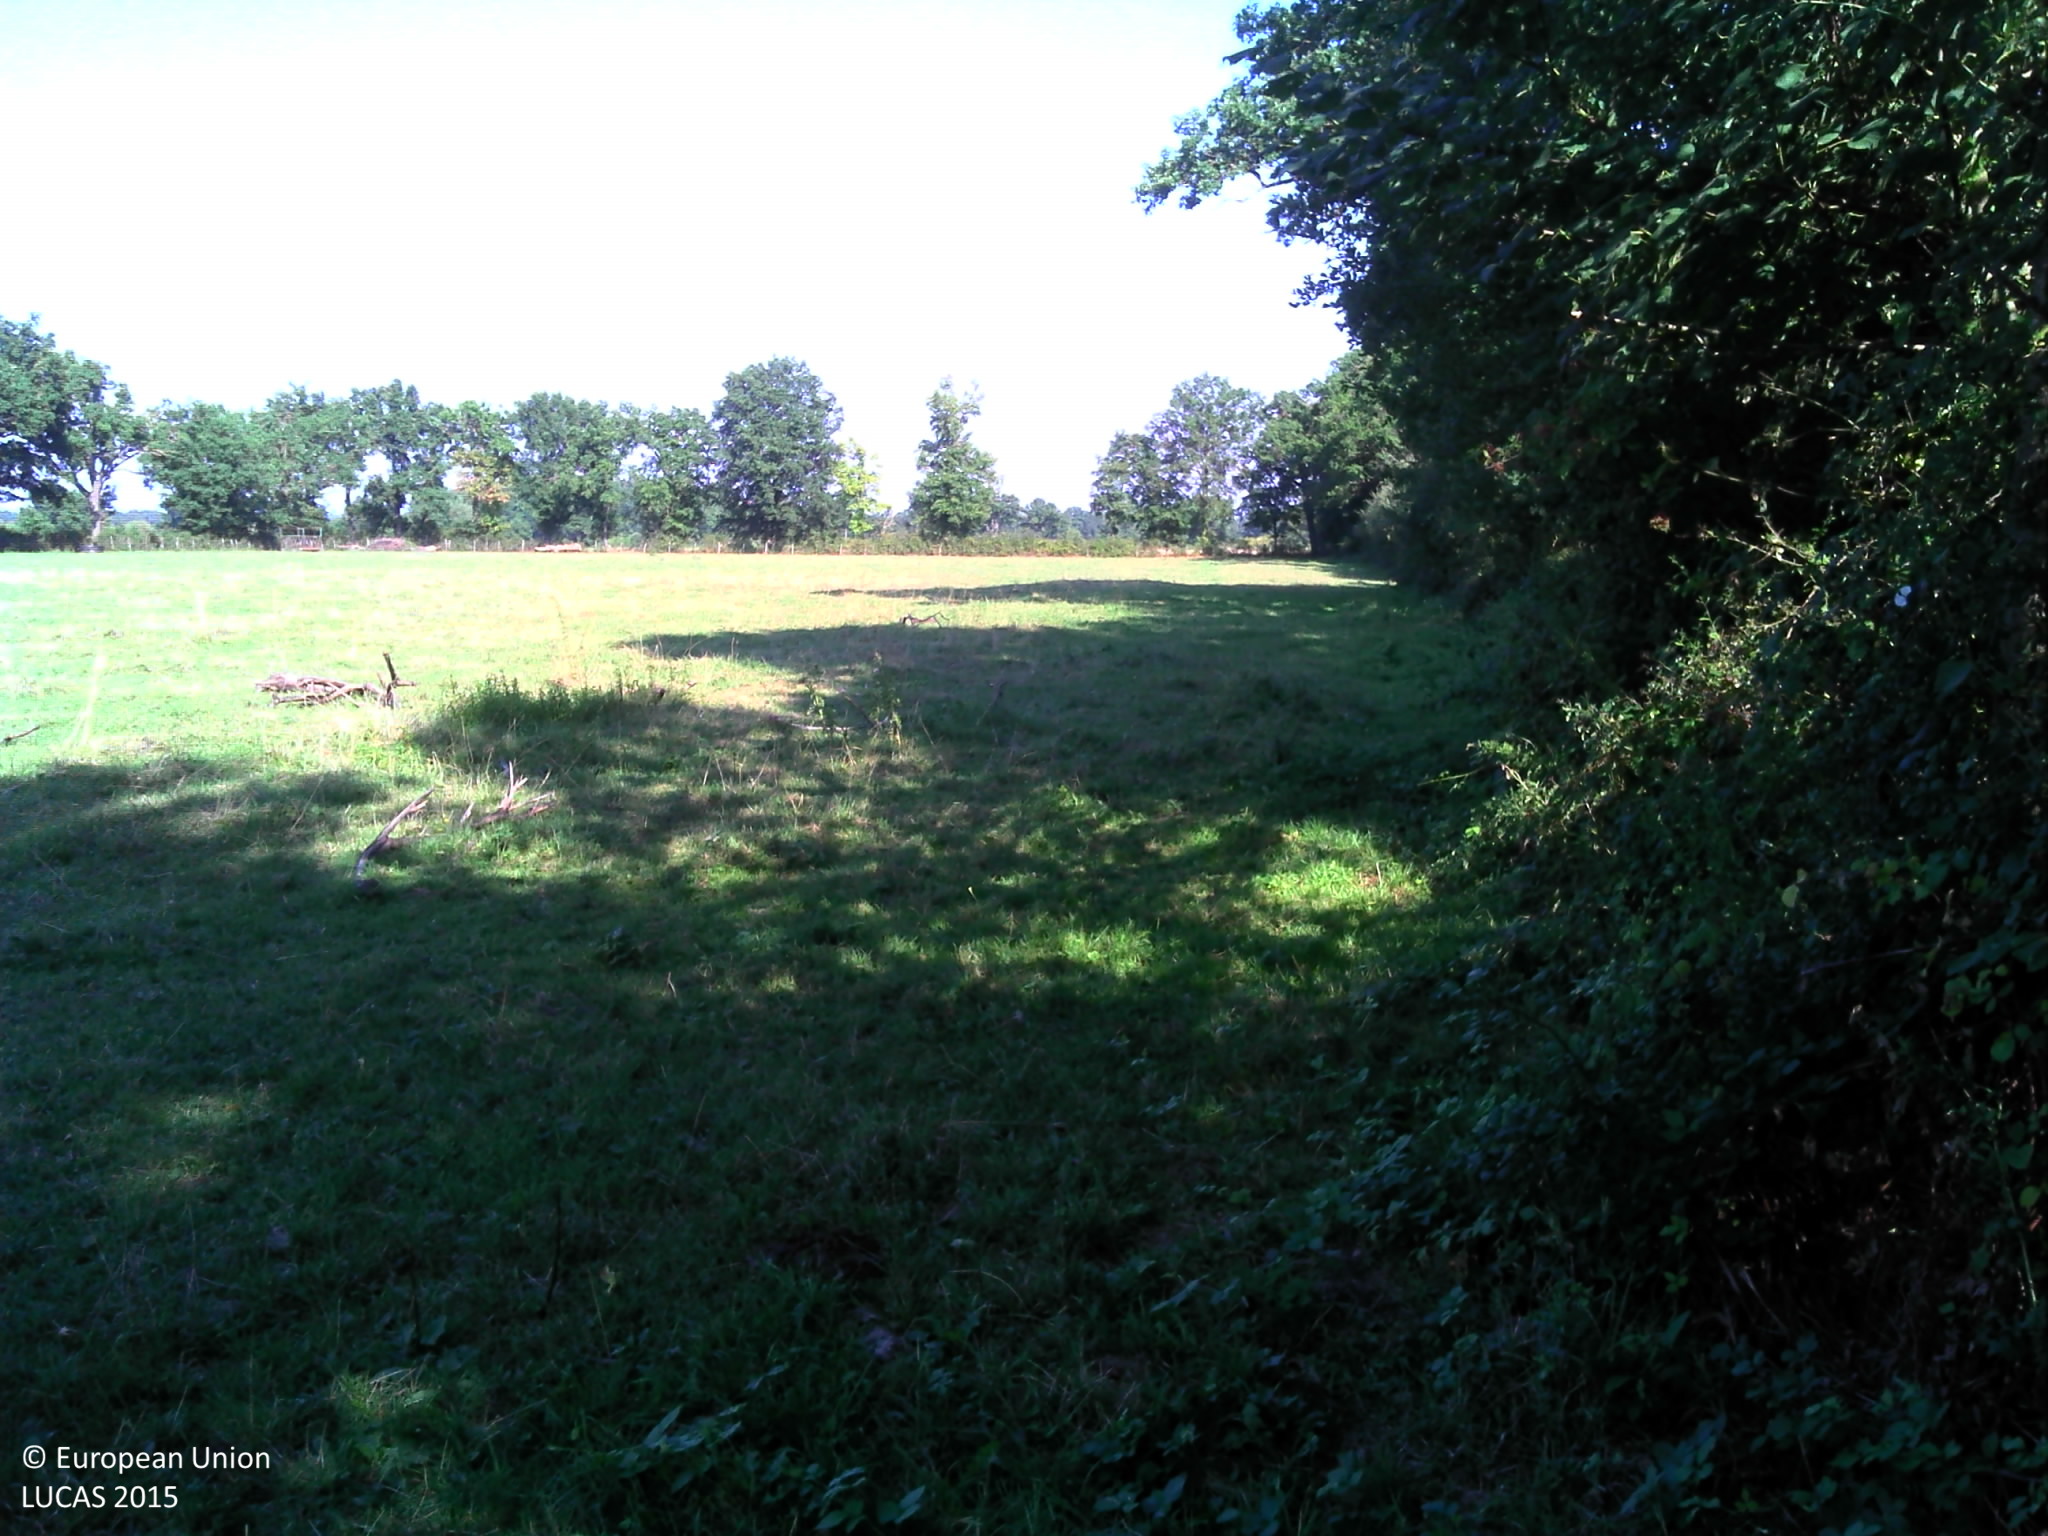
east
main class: Woodland
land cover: Broadleaved woodland
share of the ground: > 75 %
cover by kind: broadleaved forest trees 80 %, herbaceous plants 10 %, unconsolidated bare surface 10 %
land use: Forestry
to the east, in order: Fences; Broadleaved woodland; Fences; Grassland without tree/shrub cover; Broadleaved woodland; Fences; Grass margins; Ditches and canals; Tracks; Ditches and canals; Other bare soil
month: August
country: FR
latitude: 45.6638
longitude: 4.0858
